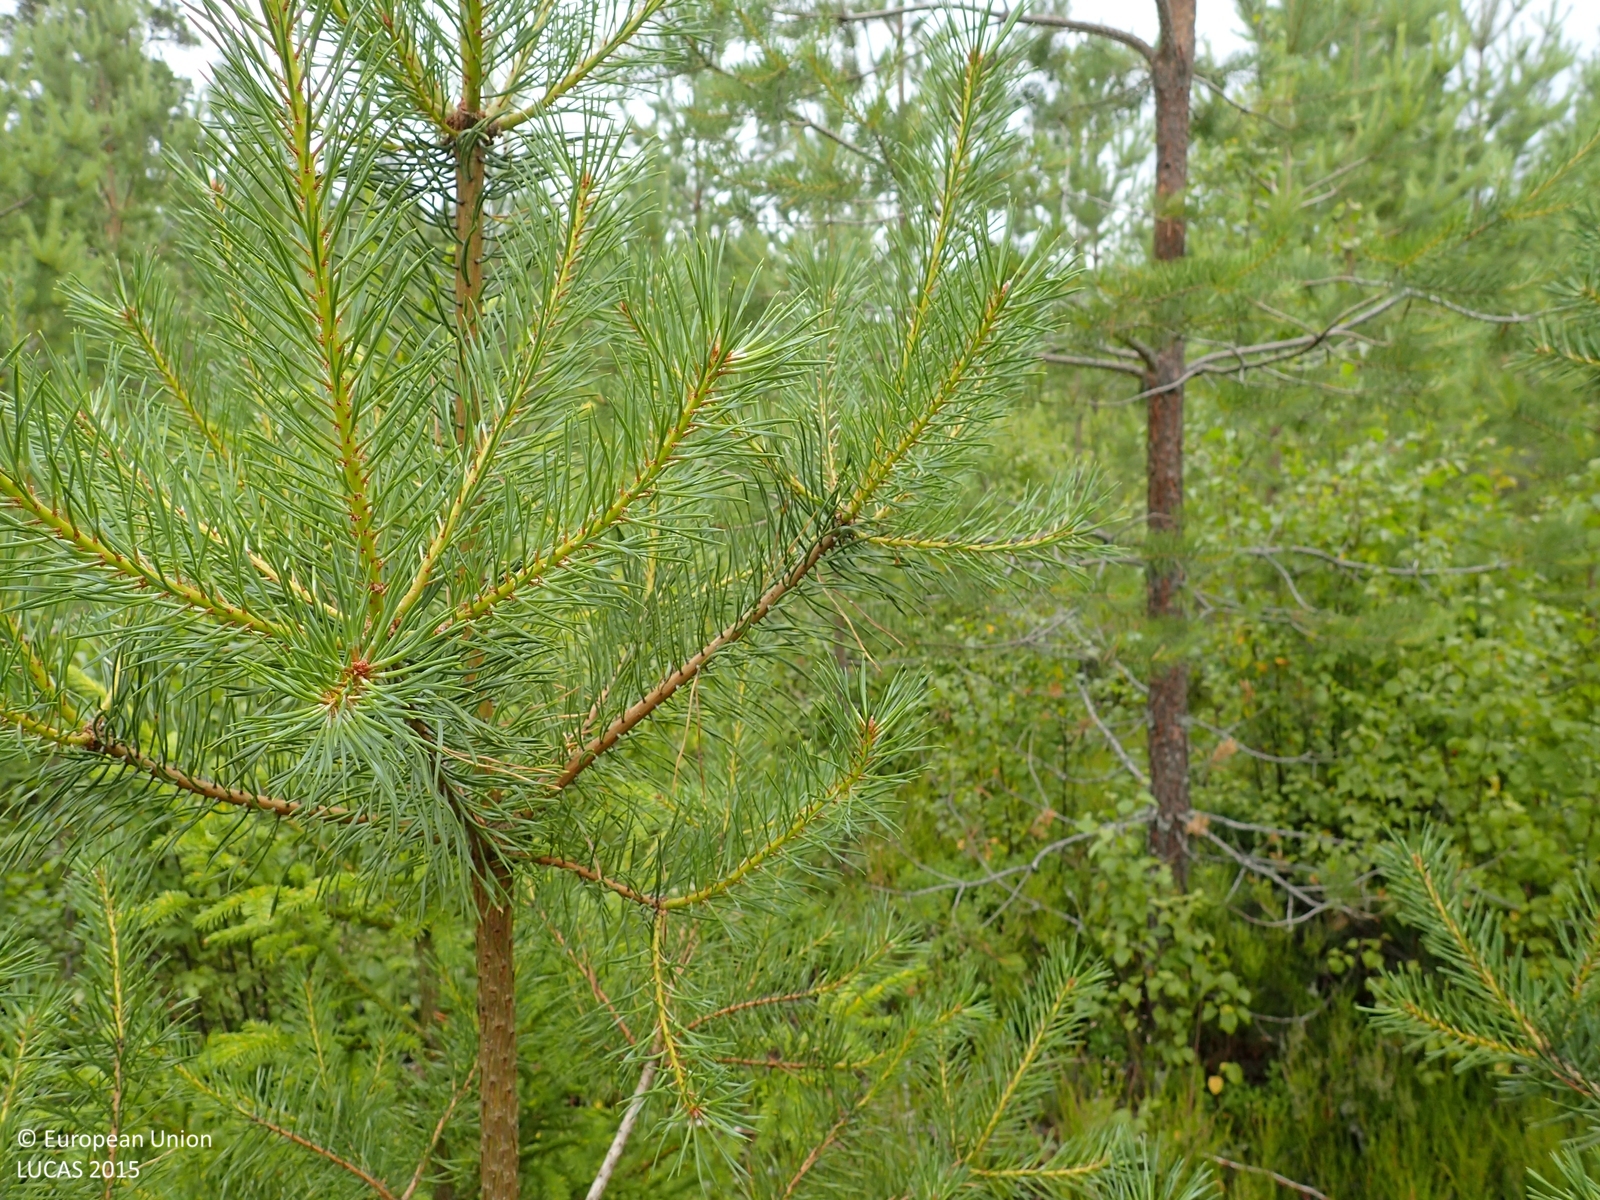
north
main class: Woodland
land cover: Pine dominated mixed woodland
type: boreal forest
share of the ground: > 75 %
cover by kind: coniferous forest trees 55 %, shrubs 25 %, broadleaved forest trees 20 %
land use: Forestry
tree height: < 5 m
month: July
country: FI
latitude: 62.8810
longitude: 23.2981
